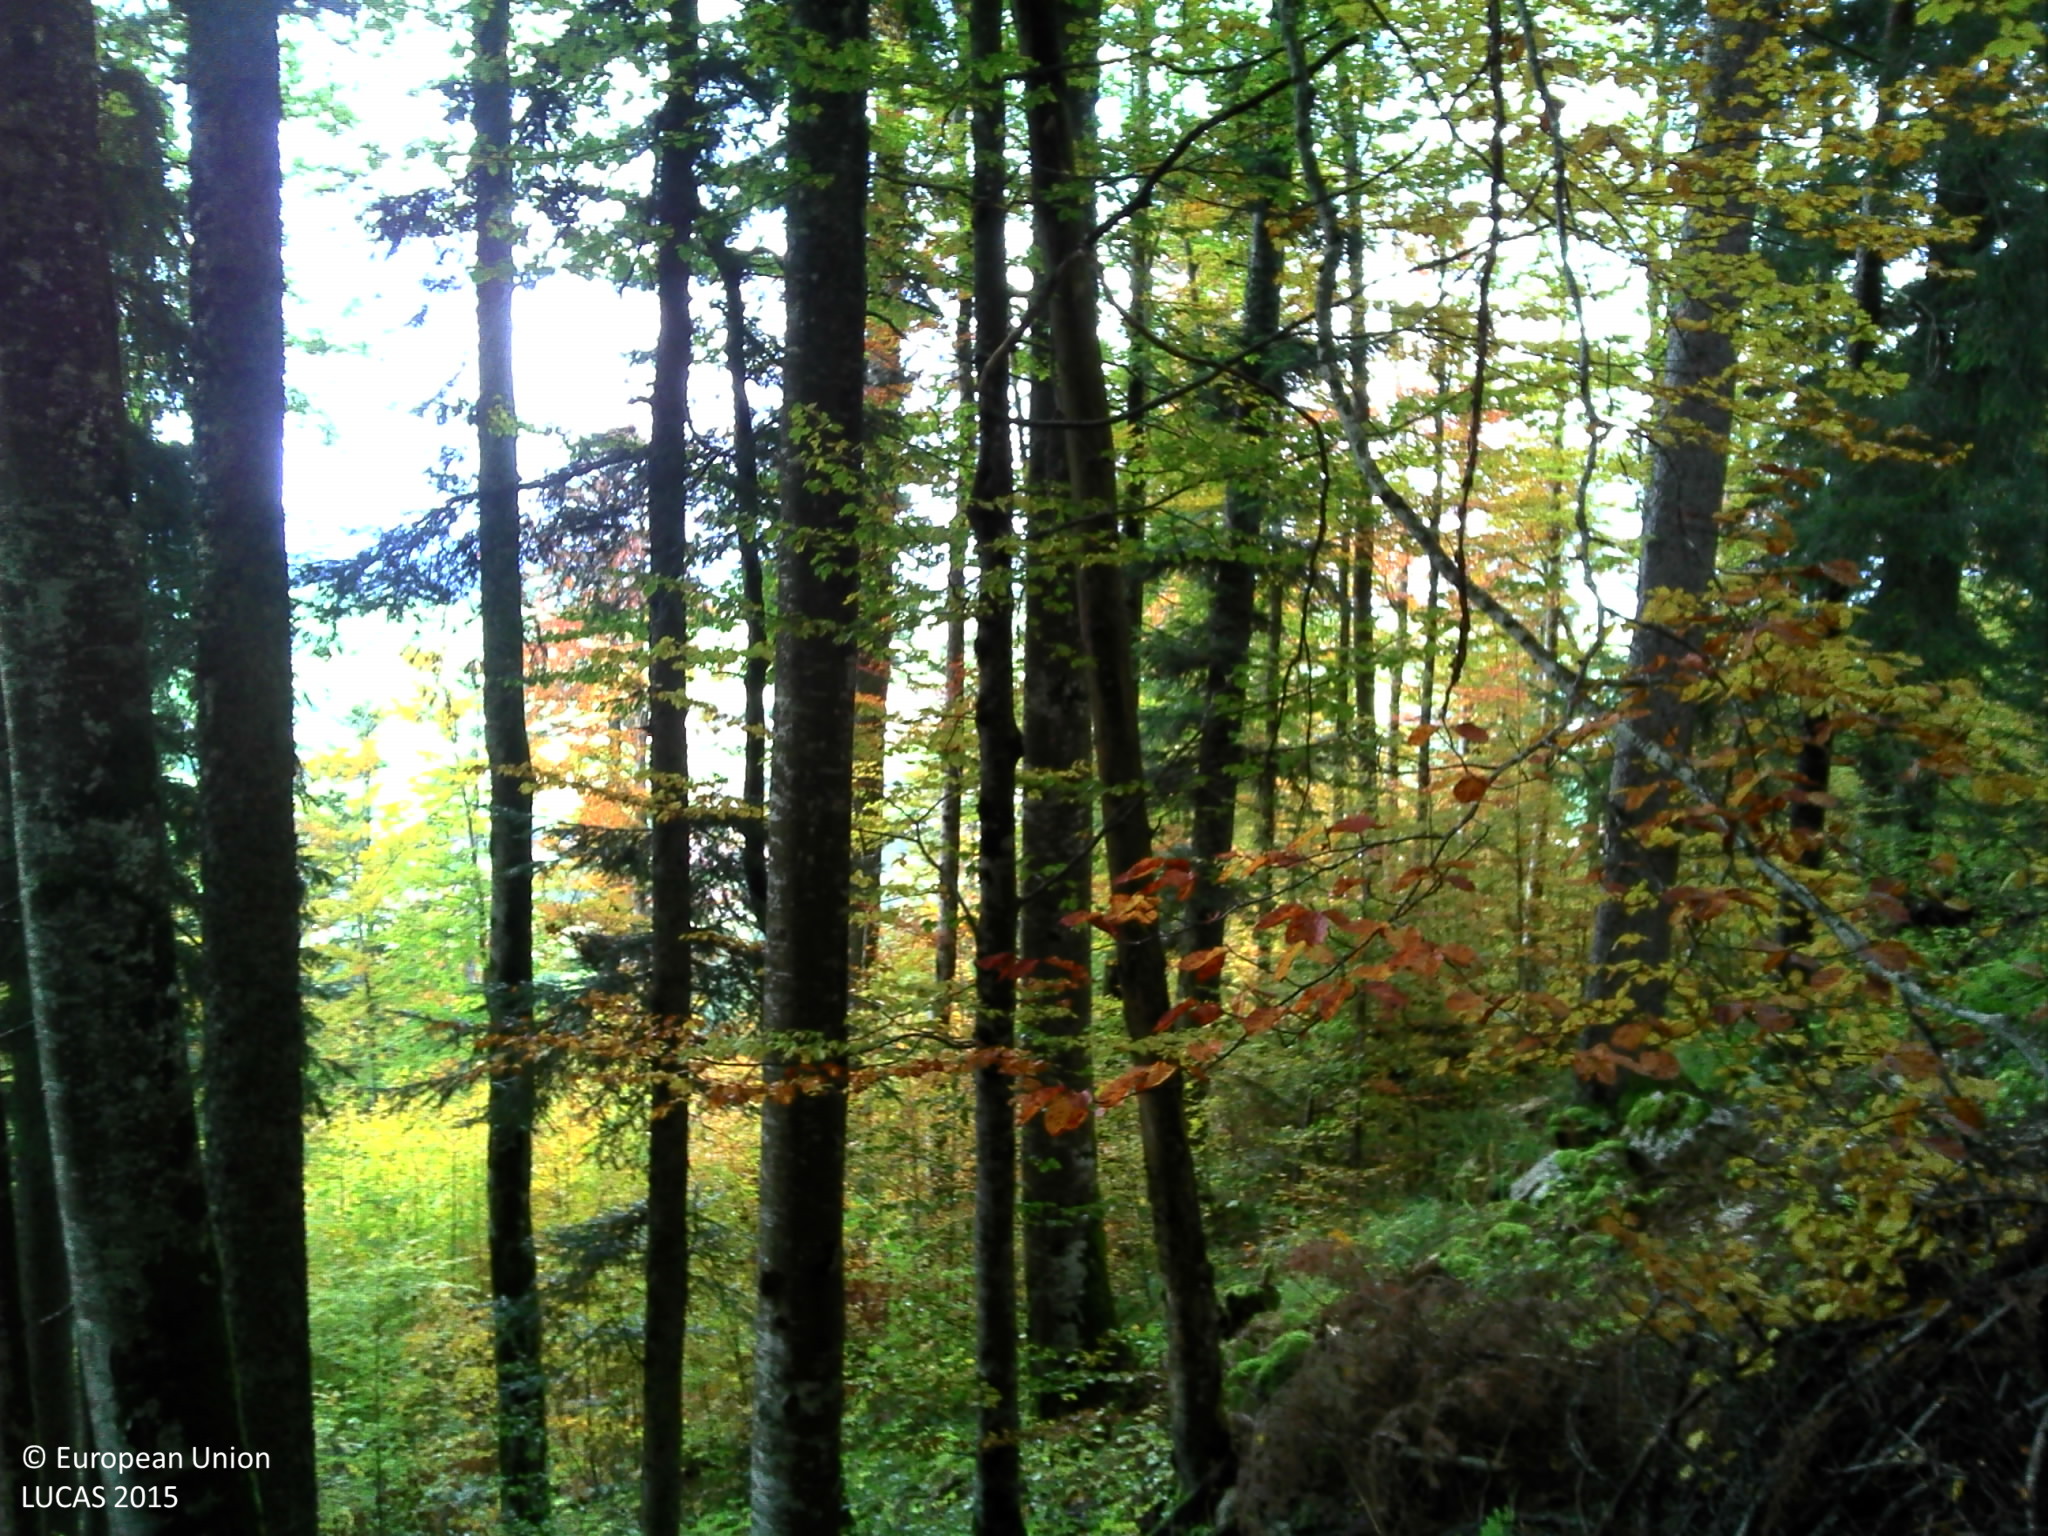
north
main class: Woodland
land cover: Spruce dominated mixed woodland
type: mountainous beech forest
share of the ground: > 75 %
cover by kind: coniferous forest trees 60 %, broadleaved forest trees 40 %
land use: Forestry
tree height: > 5 m
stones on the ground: 10 - 25 %
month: October
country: FR
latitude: 46.7577
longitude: 6.3499
